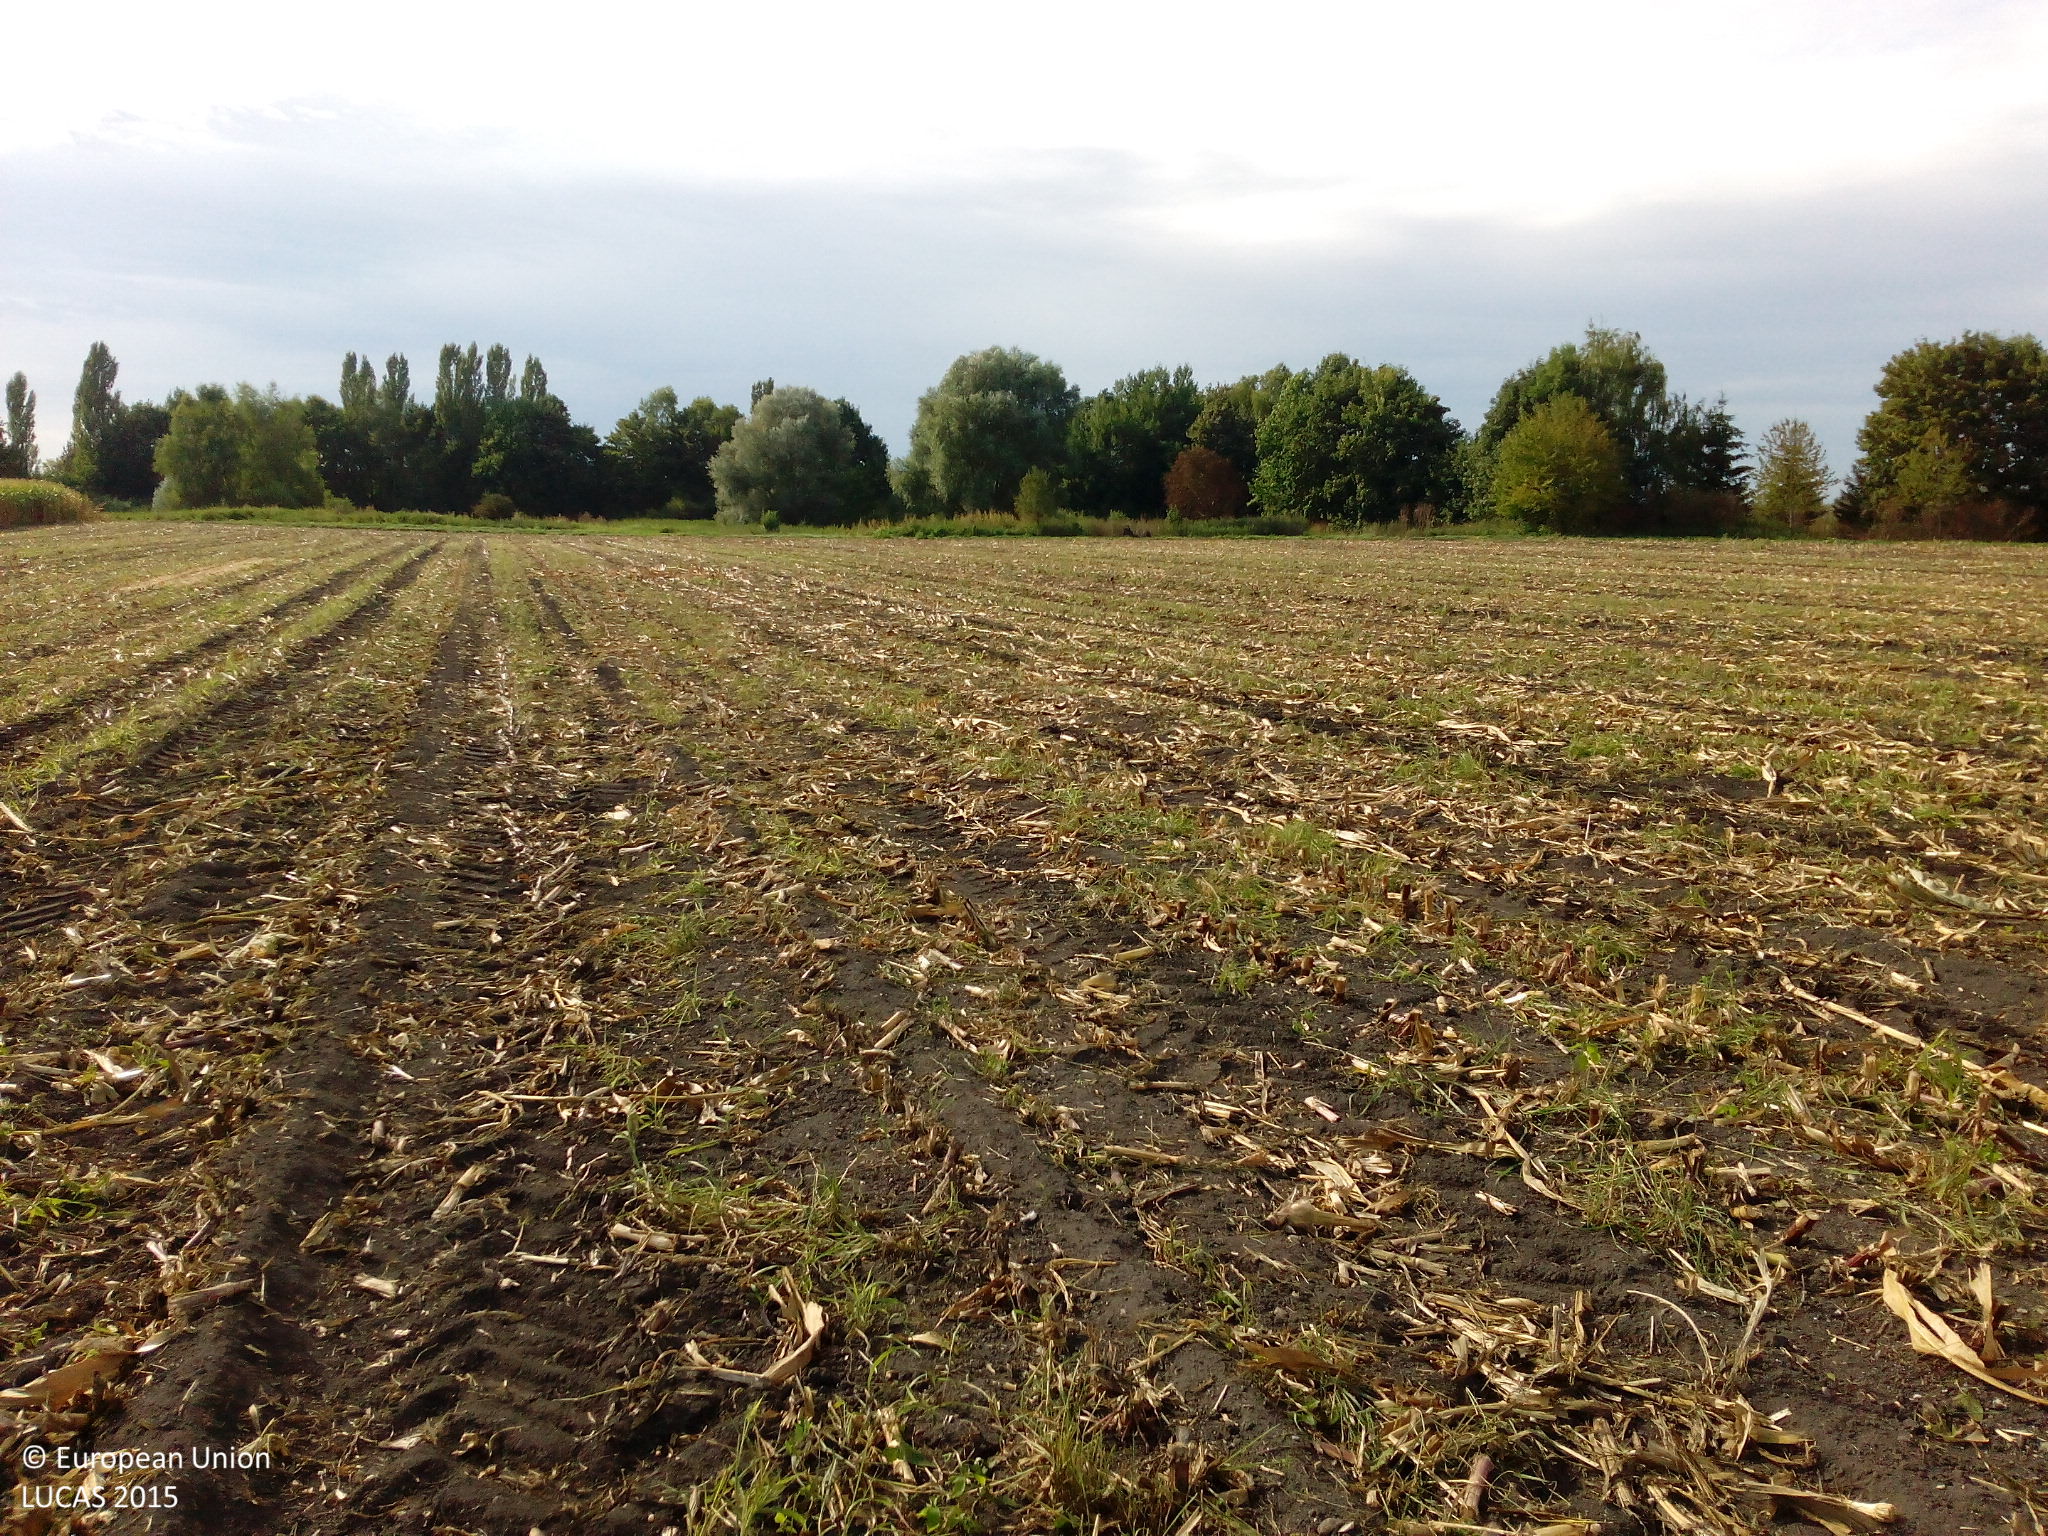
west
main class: Cropland
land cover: Maize
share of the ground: < 10 %
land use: Agriculture (excluding fallow land and kitchen gardens)
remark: Harvested field
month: September
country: DE
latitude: 48.3691
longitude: 11.9025
